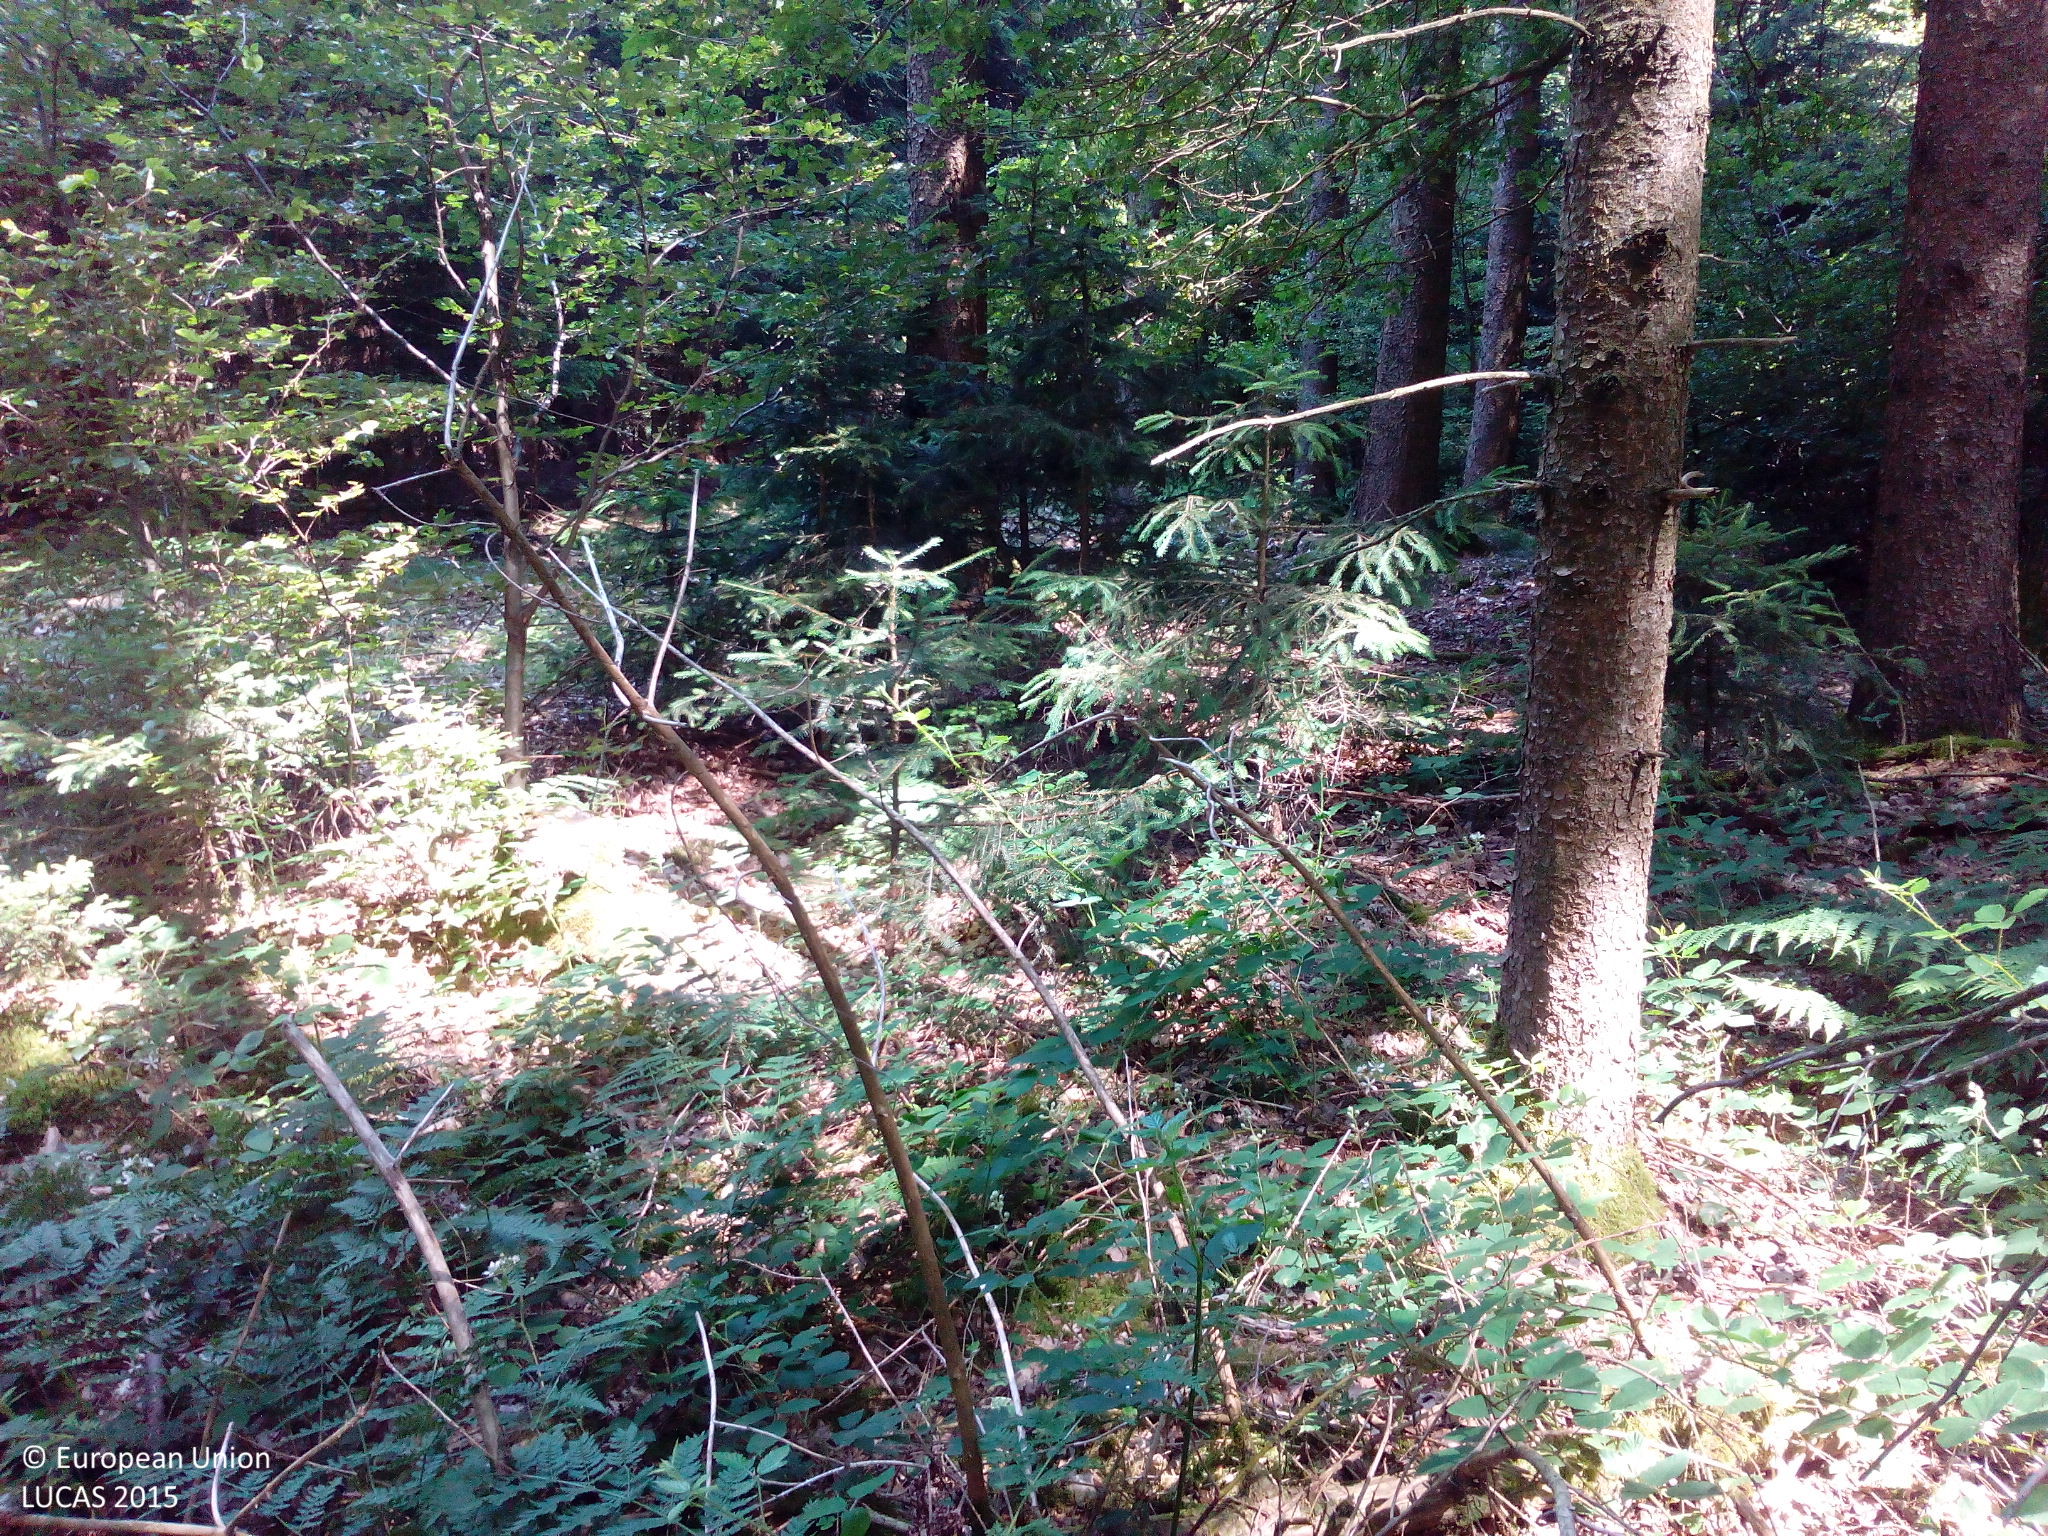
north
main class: Woodland
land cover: Other mixed woodland
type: hemiboreal forest and nemoral coniferous forest and mixed broadleaved-coniferous forest
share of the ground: > 75 %
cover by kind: broadleaved forest trees 40 %, coniferous forest trees 35 %, herbaceous plants 10 %, shrubs 5 %, lichens and mosses 5 %, unconsolidated bare surface 5 %
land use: Forestry
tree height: > 5 m
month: June
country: DE
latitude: 48.5430
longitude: 10.9883
